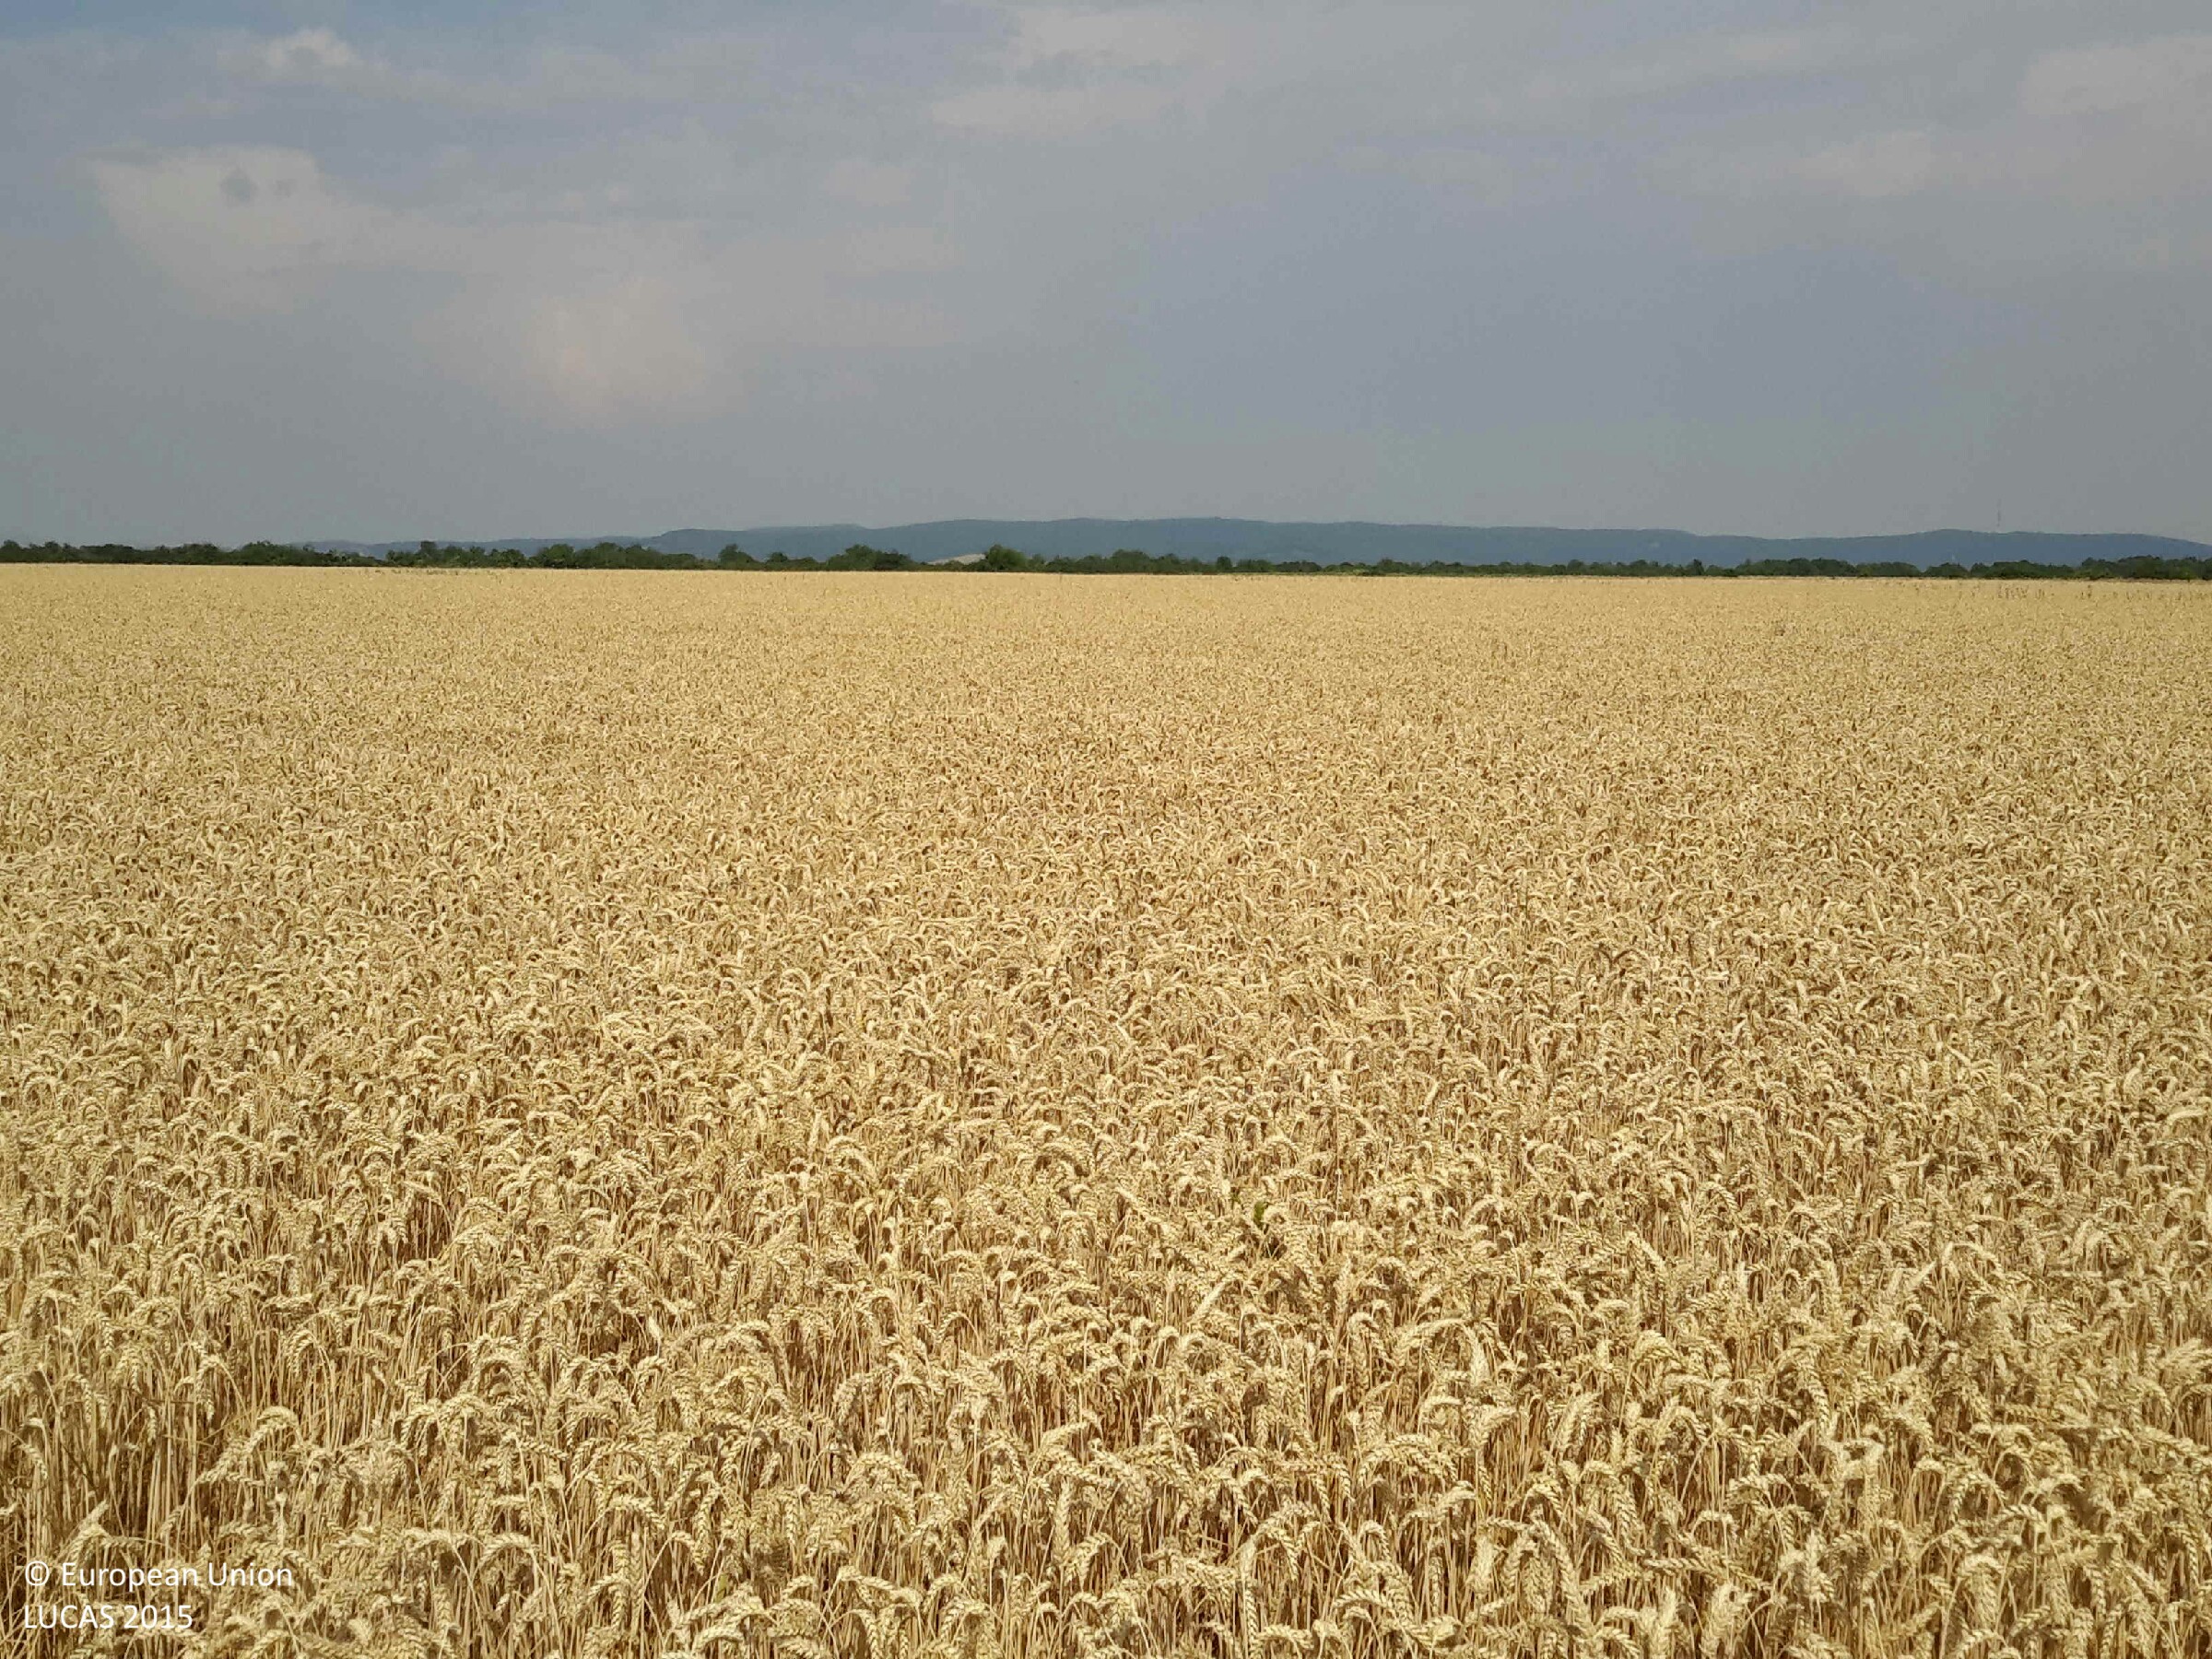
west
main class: Cropland
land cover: Common wheat
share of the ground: > 75 %
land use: Agriculture (excluding fallow land and kitchen gardens)
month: July
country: HU
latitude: 47.6062
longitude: 16.6690
